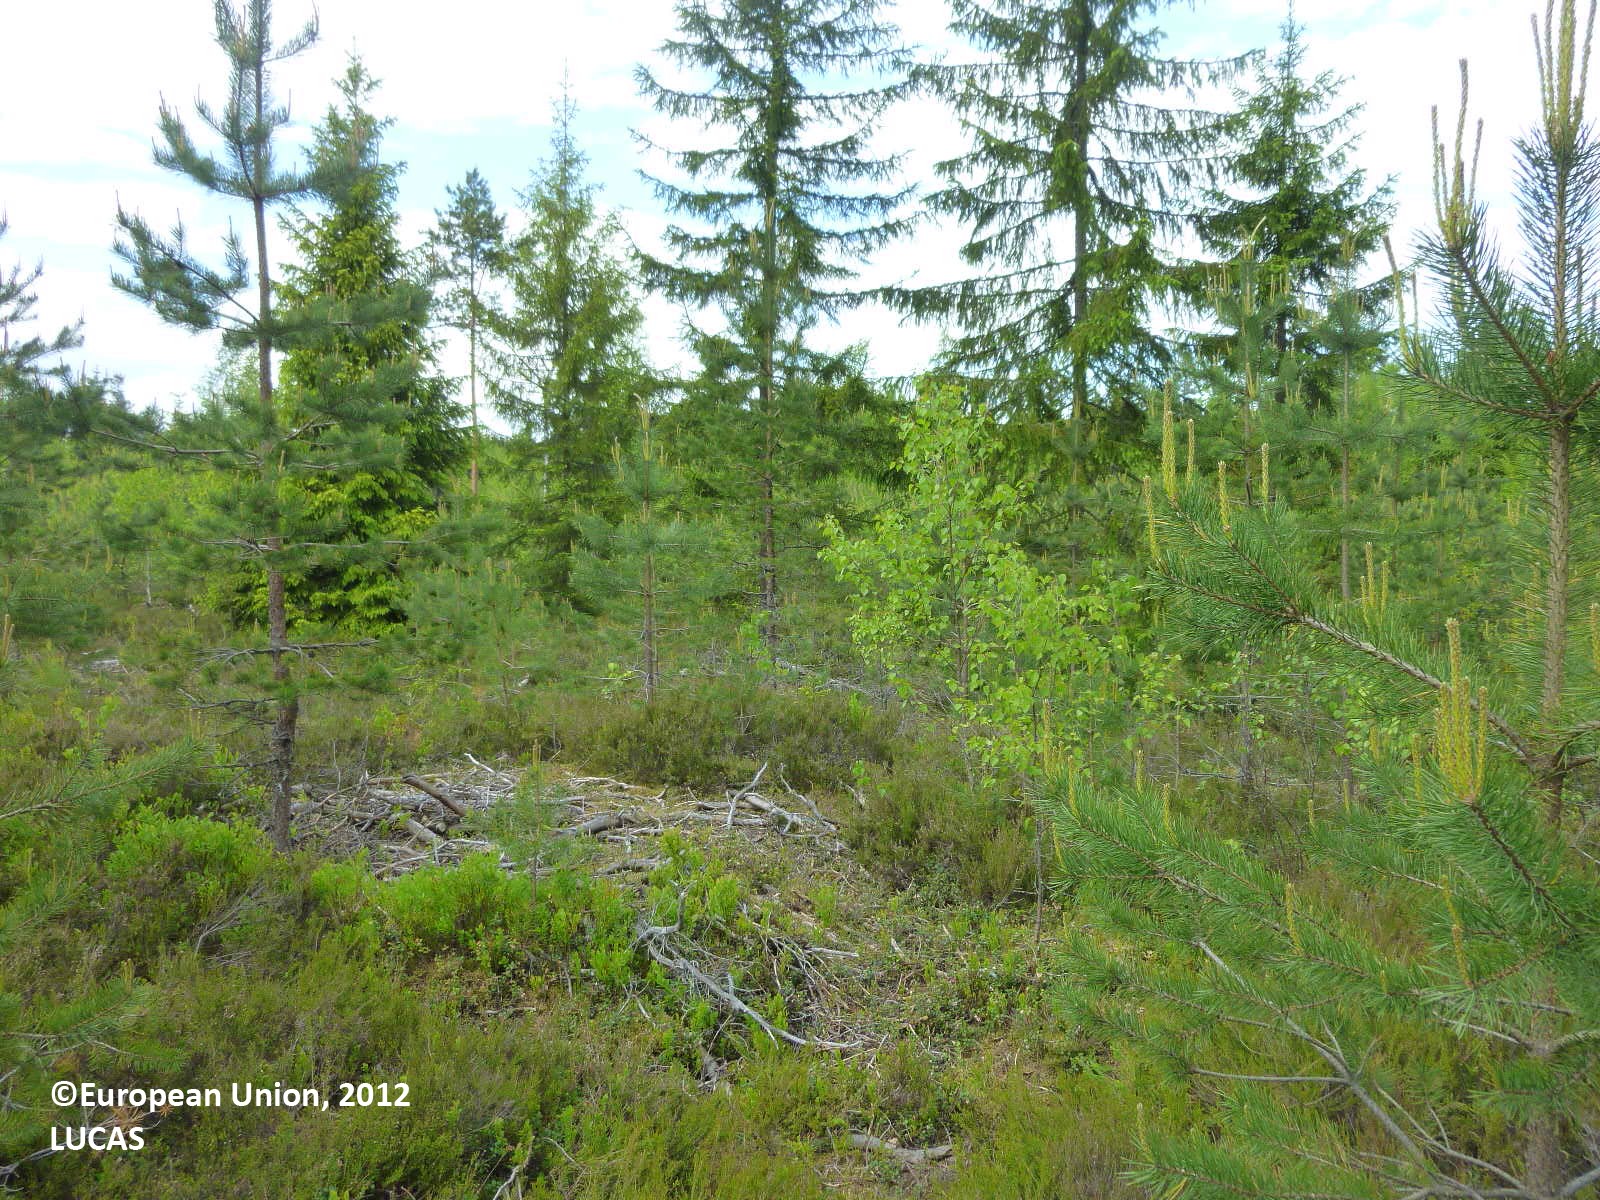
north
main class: Woodland
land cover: Pine dominated coniferous woodland
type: boreal forest
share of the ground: 25 - 50 %
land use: Forestry
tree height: > 5 m
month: June
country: FI
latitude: 60.5850
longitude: 22.7597
